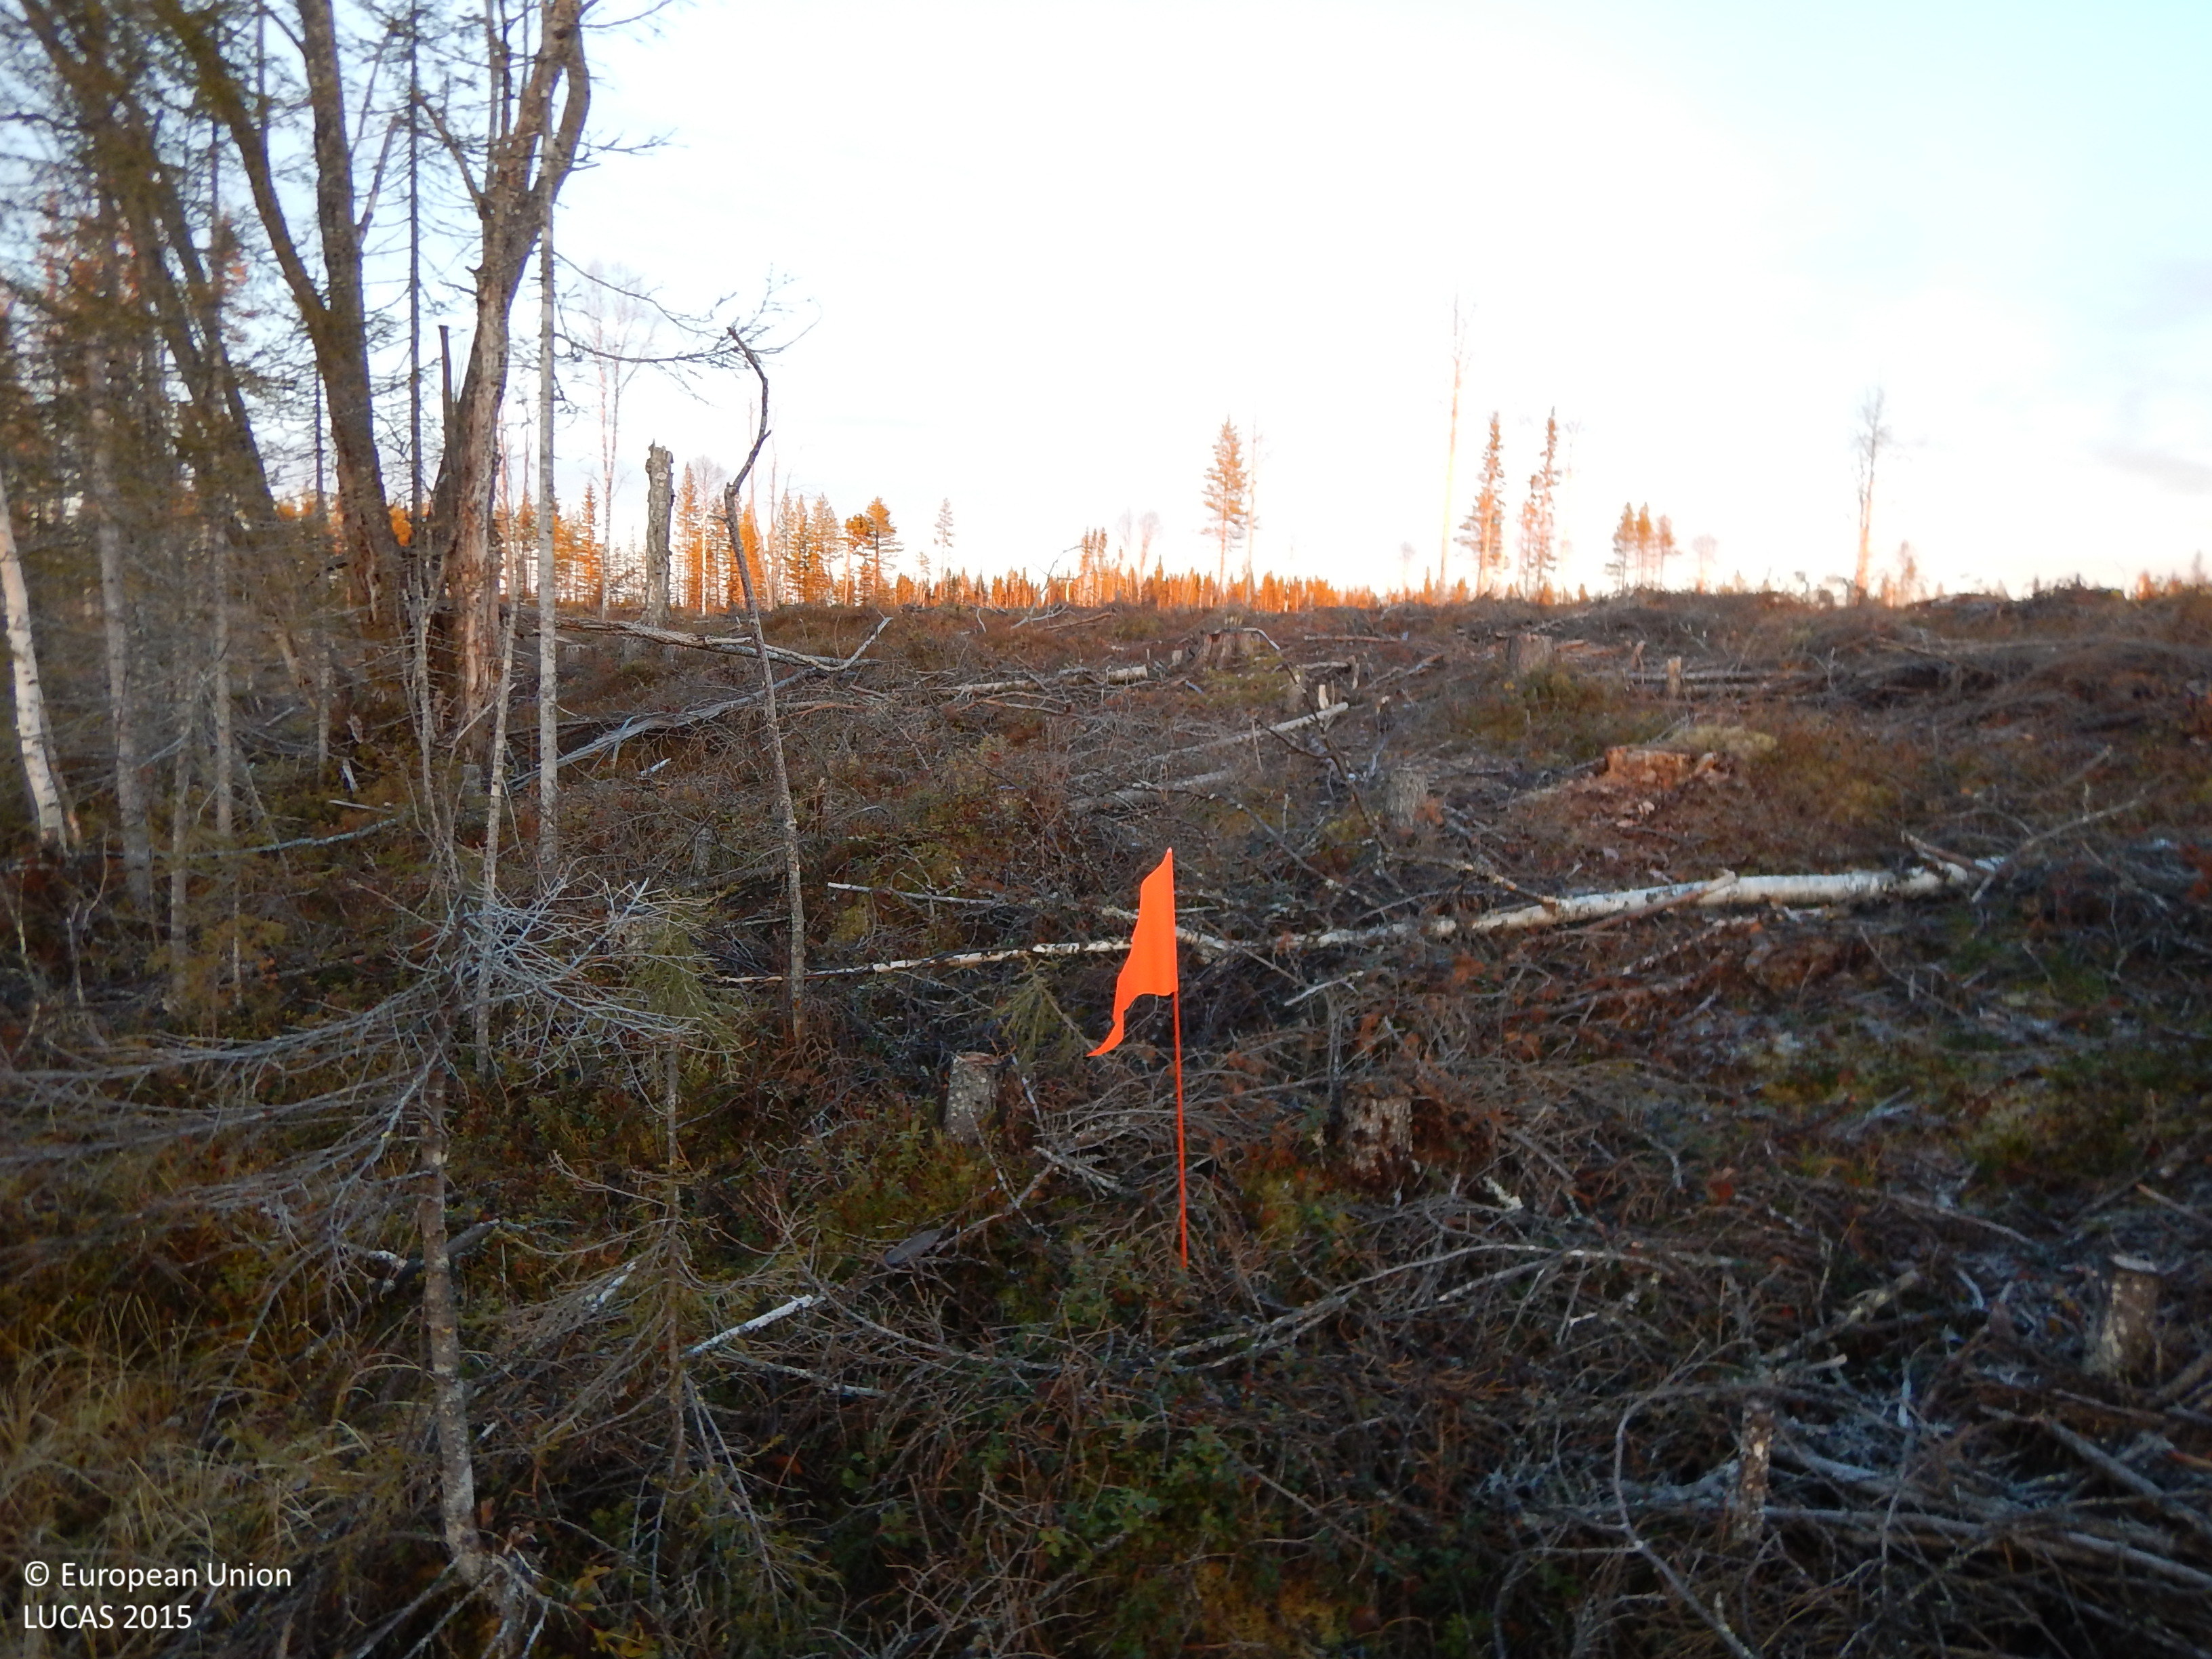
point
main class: Shrubland
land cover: Shrubland with sparse tree cover
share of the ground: 25 - 50 %
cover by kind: shrubs 40 %, herbaceous plants 25 %, lichens and mosses 20 %, coniferous forest trees 5 %
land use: Forestry
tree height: > 5 m
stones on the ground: < 10 %
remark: Clear cut
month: November
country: SE
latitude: 65.2115
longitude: 20.5944
